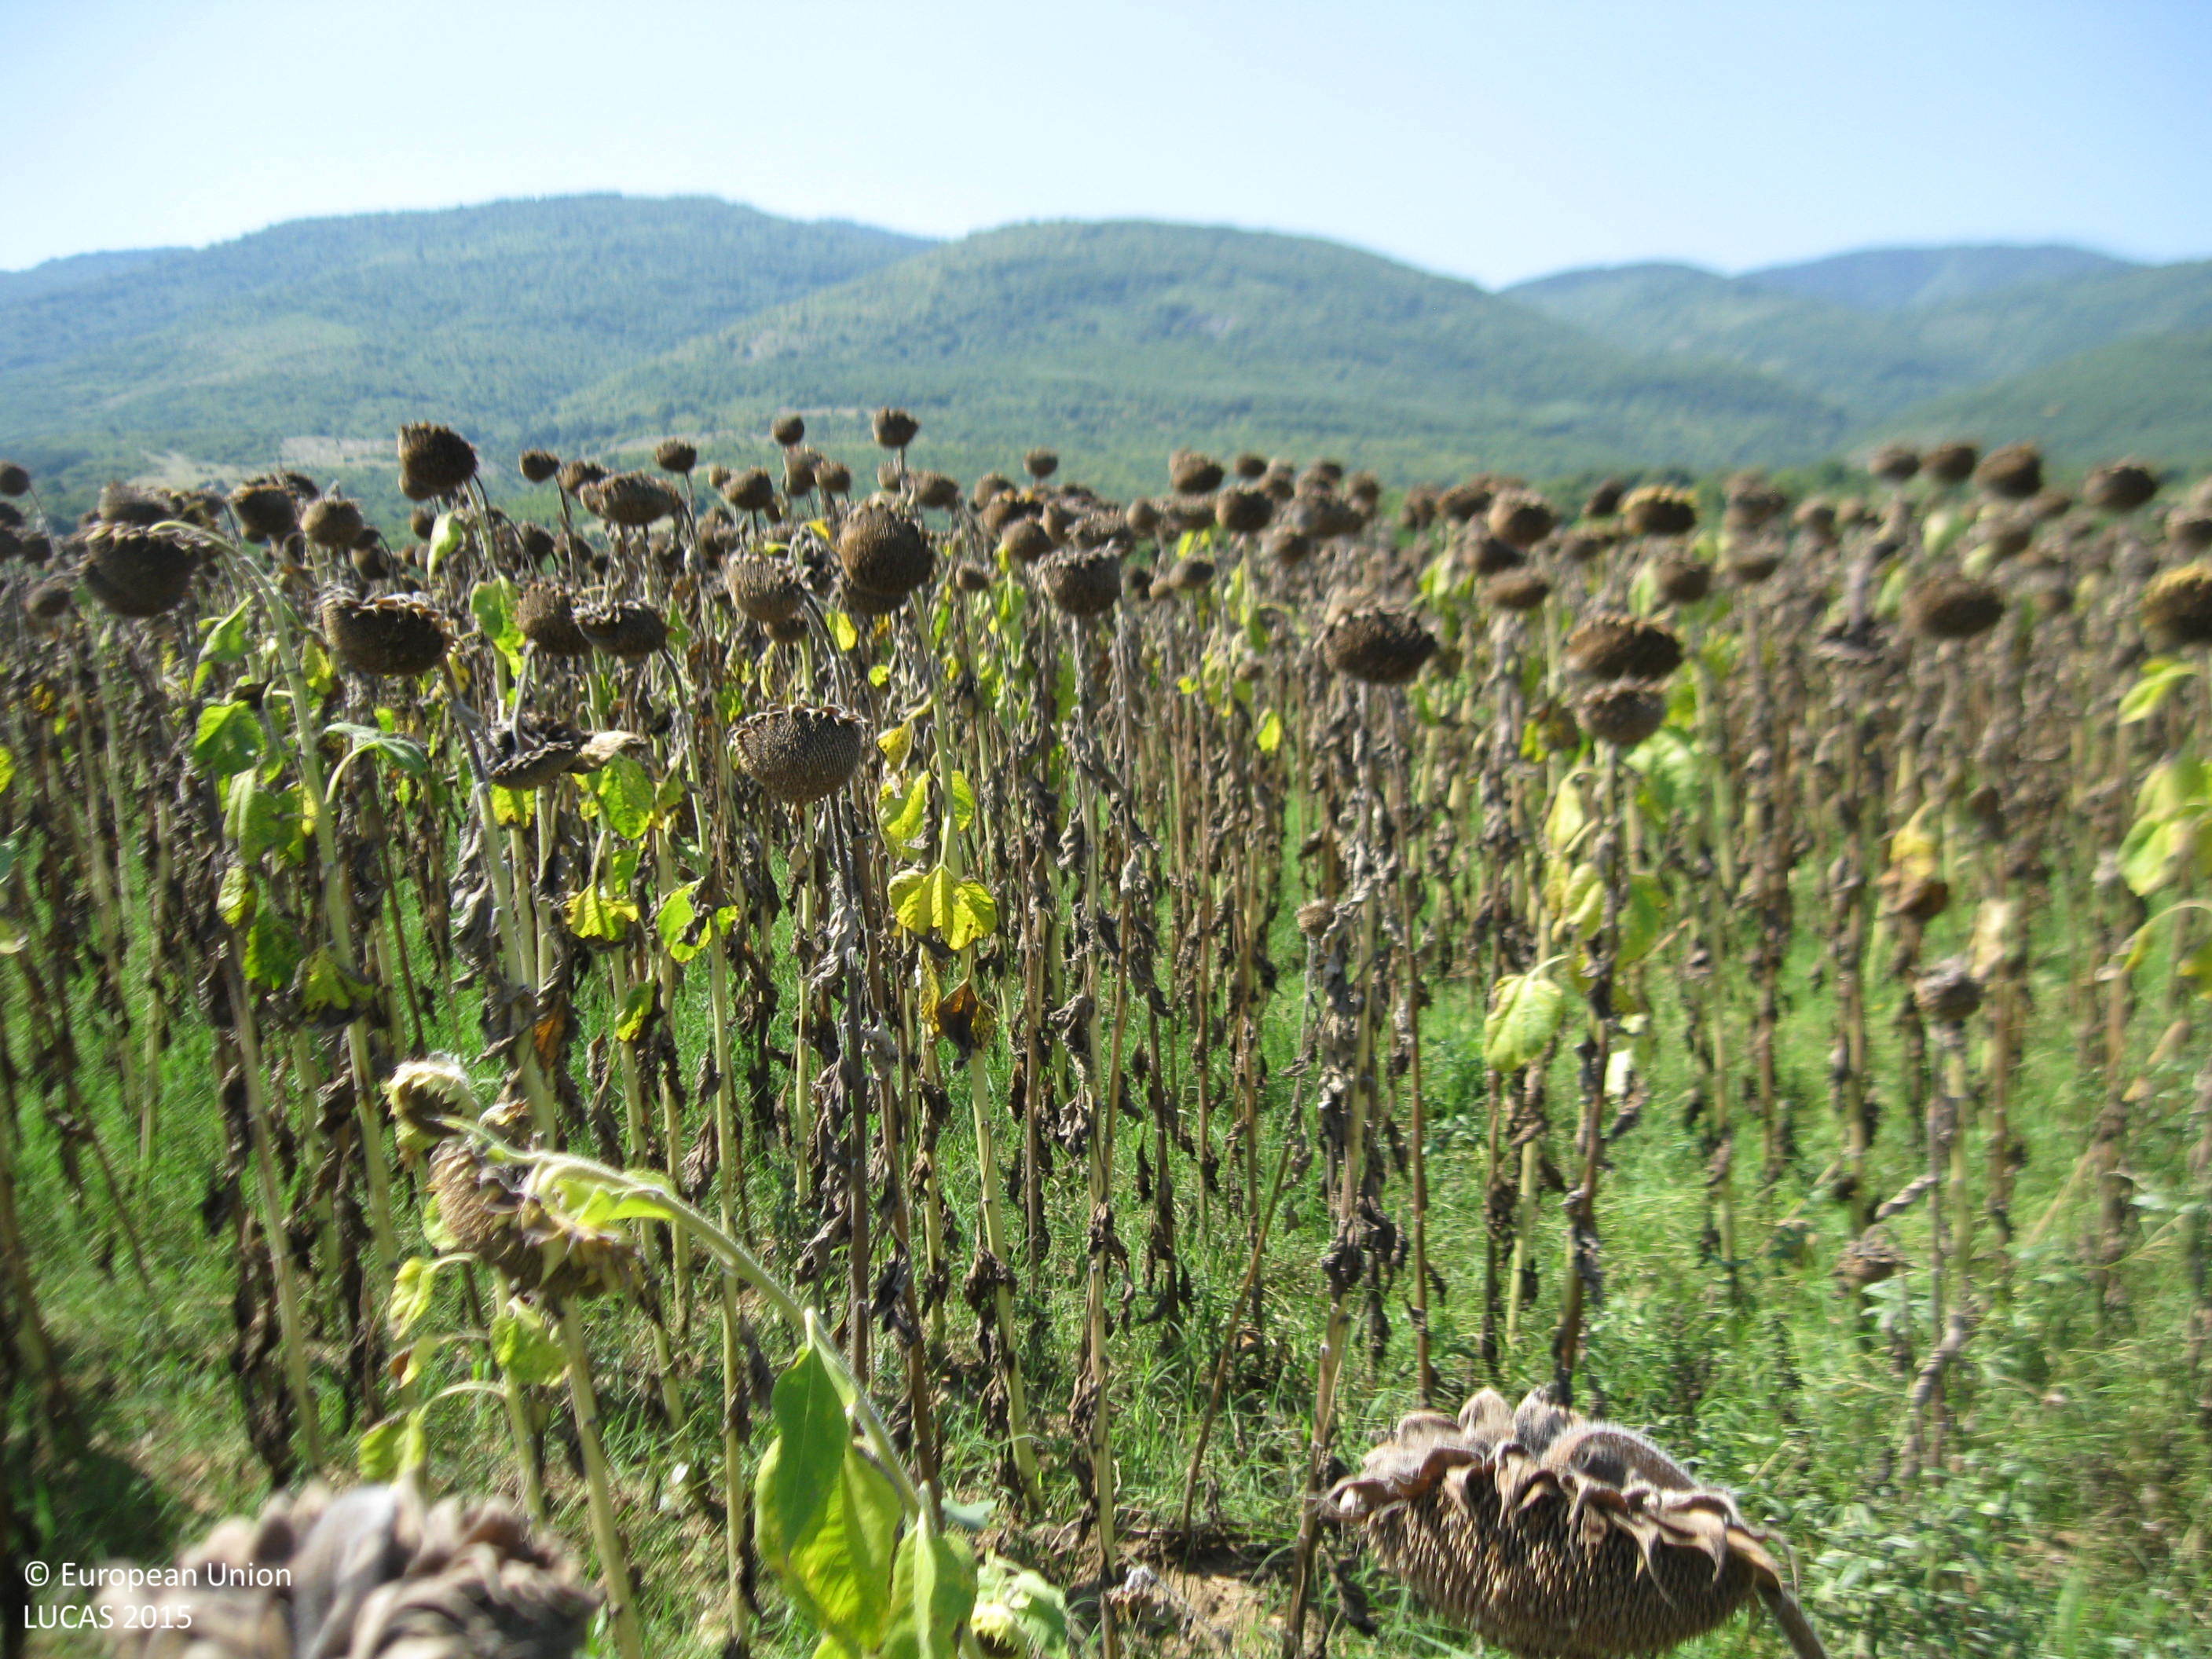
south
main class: Cropland
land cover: Sunflower
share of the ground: > 75 %
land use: Agriculture (excluding fallow land and kitchen gardens)
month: August
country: BG
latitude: 41.9585
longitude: 24.9532
